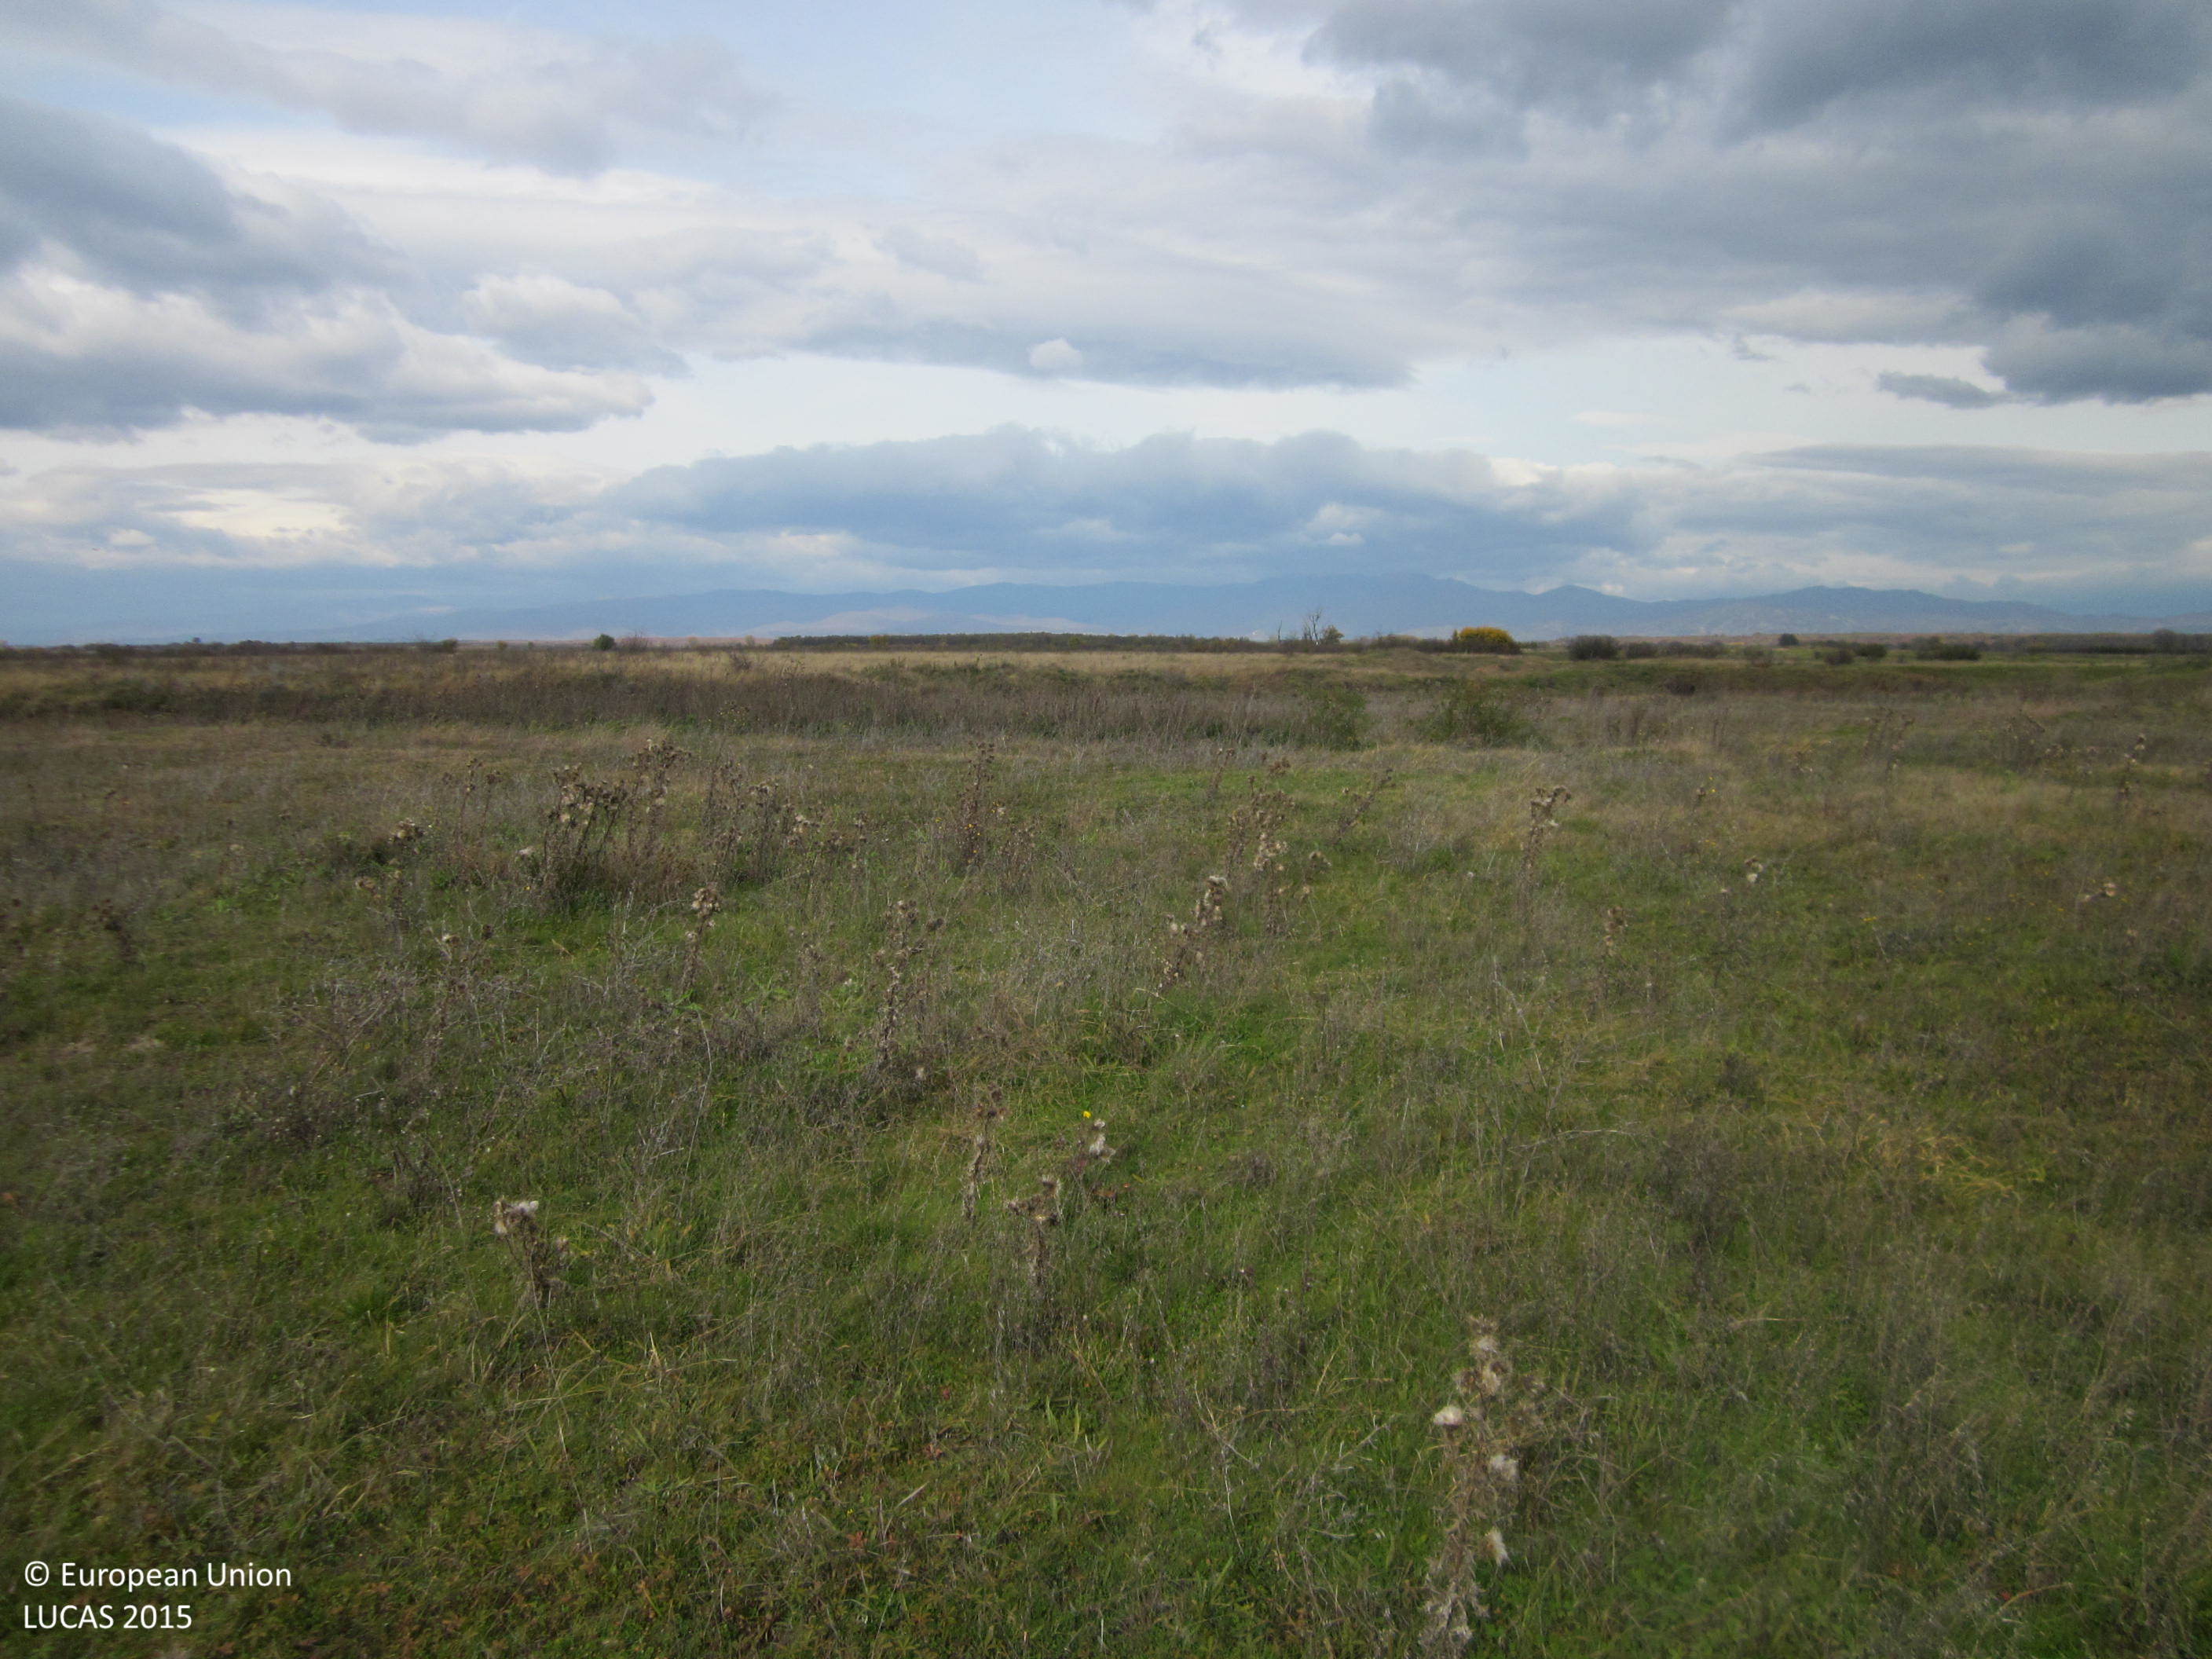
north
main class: Grassland
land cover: Grassland without tree/shrub cover
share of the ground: > 75 %
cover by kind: herbaceous plants 100 %
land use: Agriculture (excluding fallow land and kitchen gardens)
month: November
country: BG
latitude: 42.3402
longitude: 24.6042
